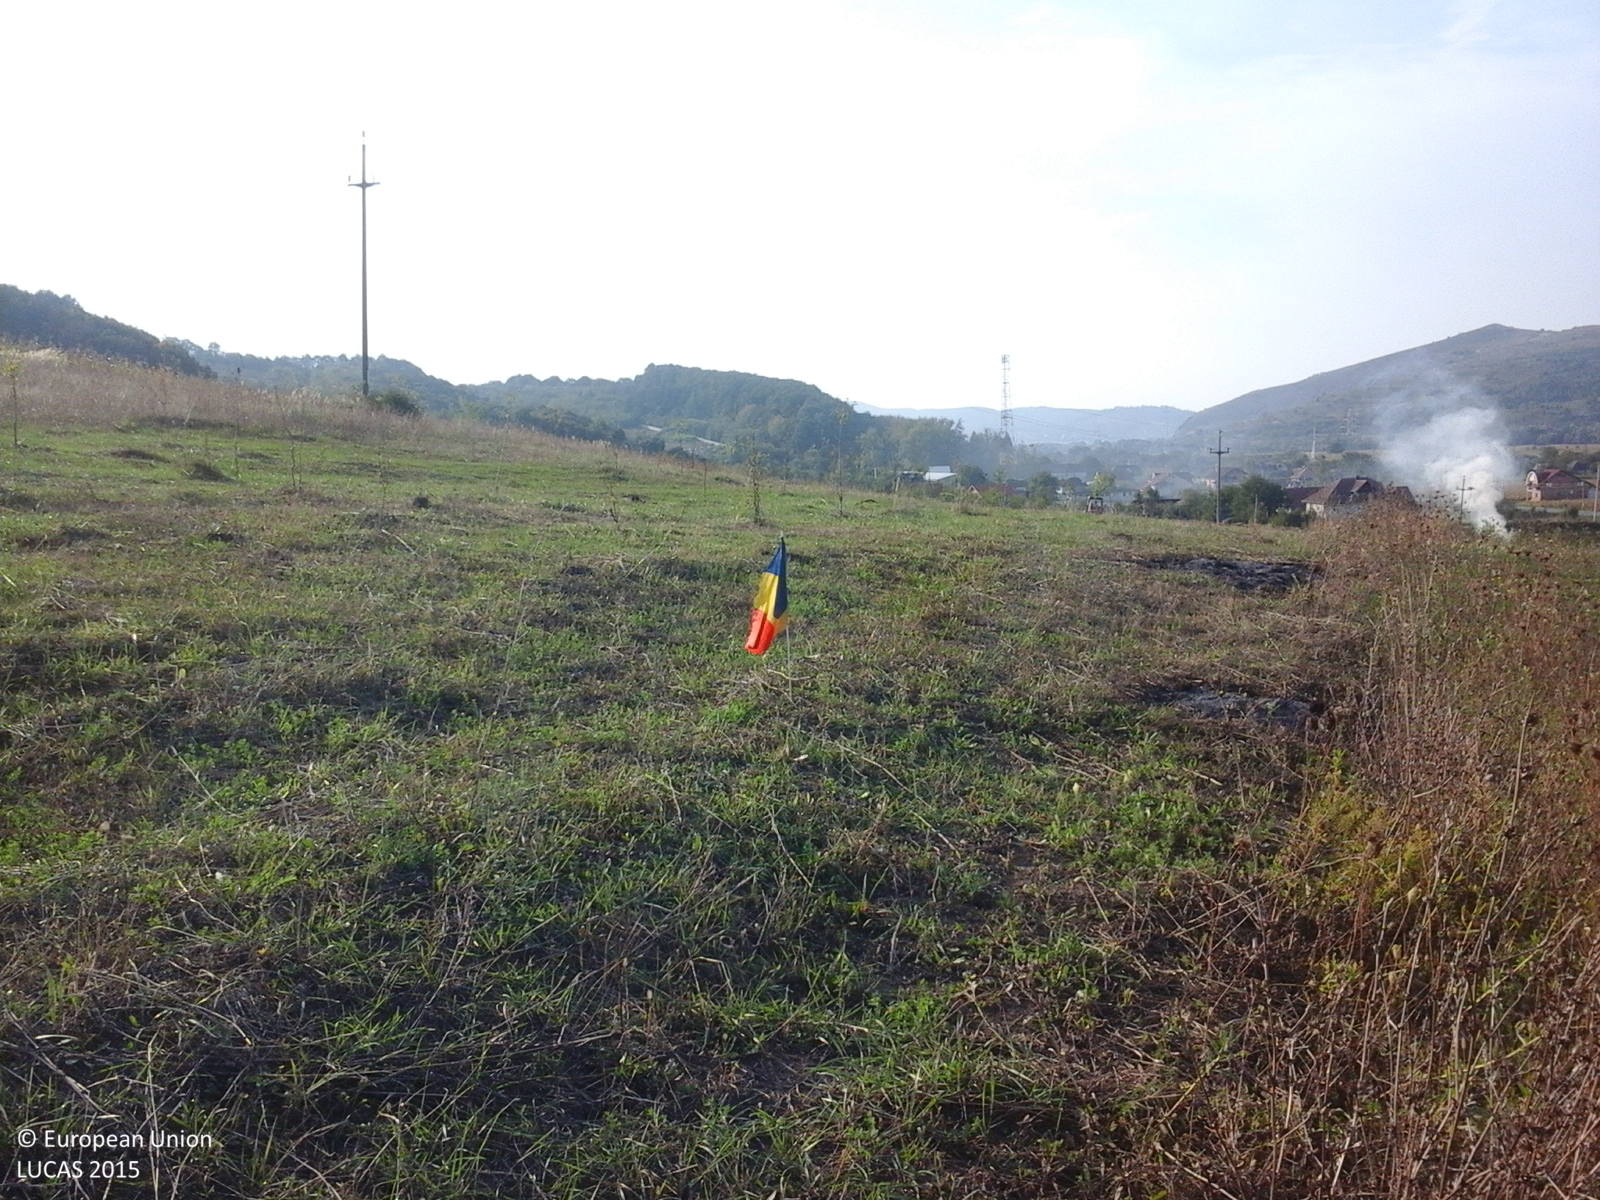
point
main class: Cropland
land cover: Other fruit trees and berries
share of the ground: > 75 %
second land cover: Grassland without tree/shrub cover
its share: > 75 %
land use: Agriculture (excluding fallow land and kitchen gardens)
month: September
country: RO
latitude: 47.2289
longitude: 23.3161
